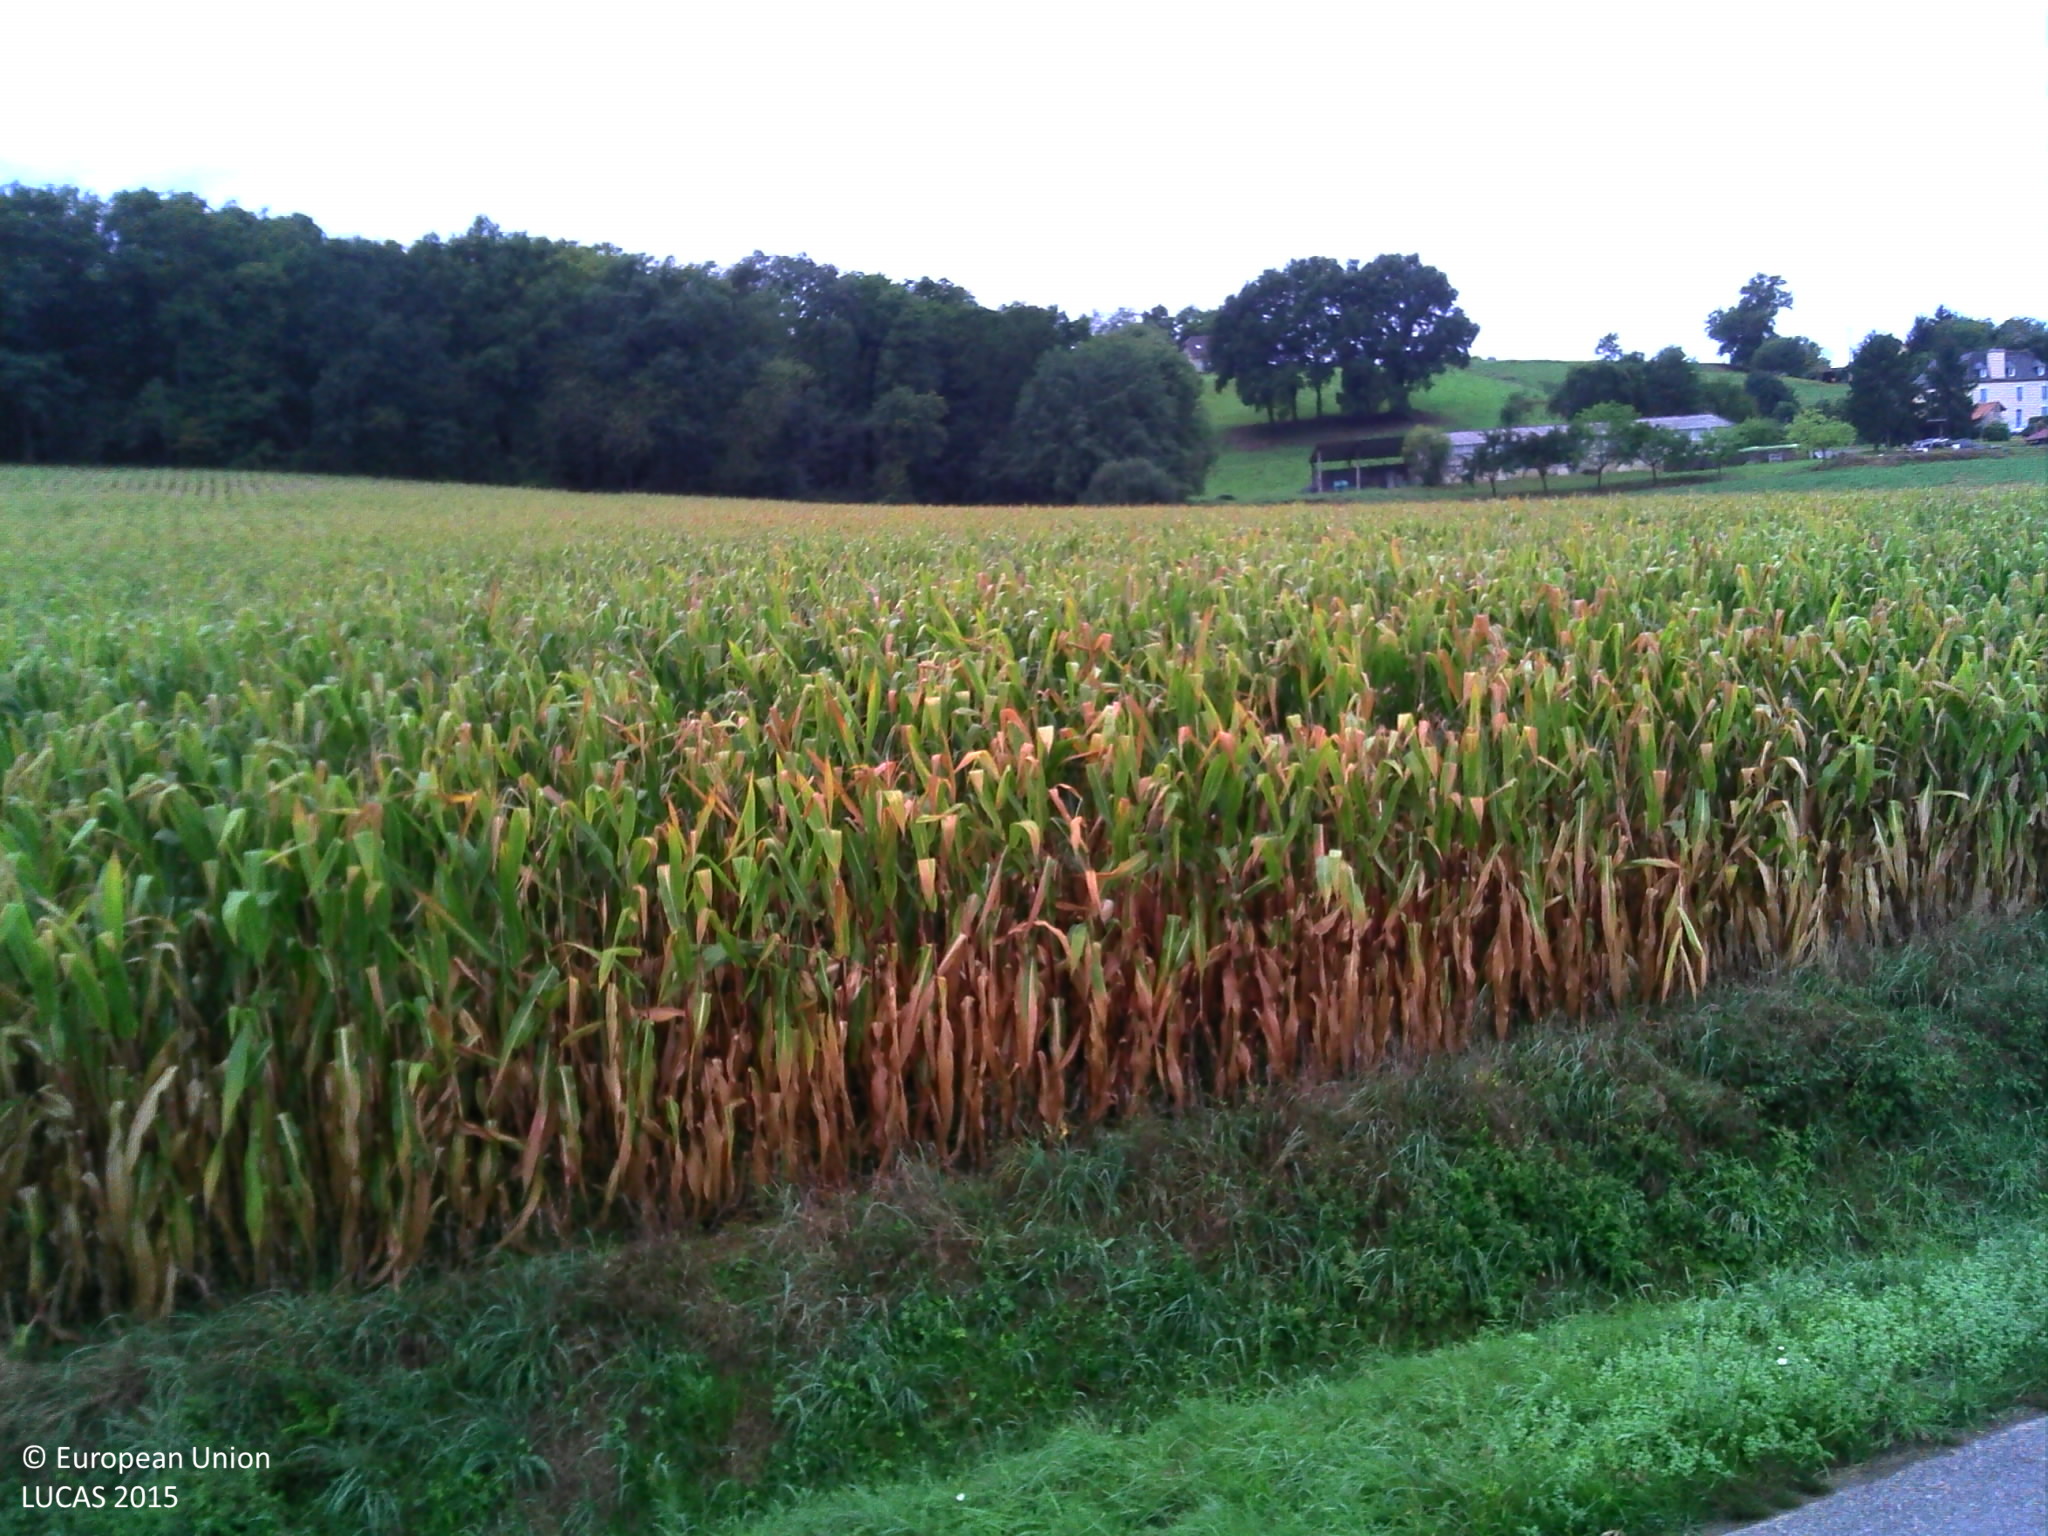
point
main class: Cropland
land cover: Maize
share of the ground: > 75 %
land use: Agriculture (excluding fallow land and kitchen gardens)
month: September
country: FR
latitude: 43.4502
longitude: -0.5252
